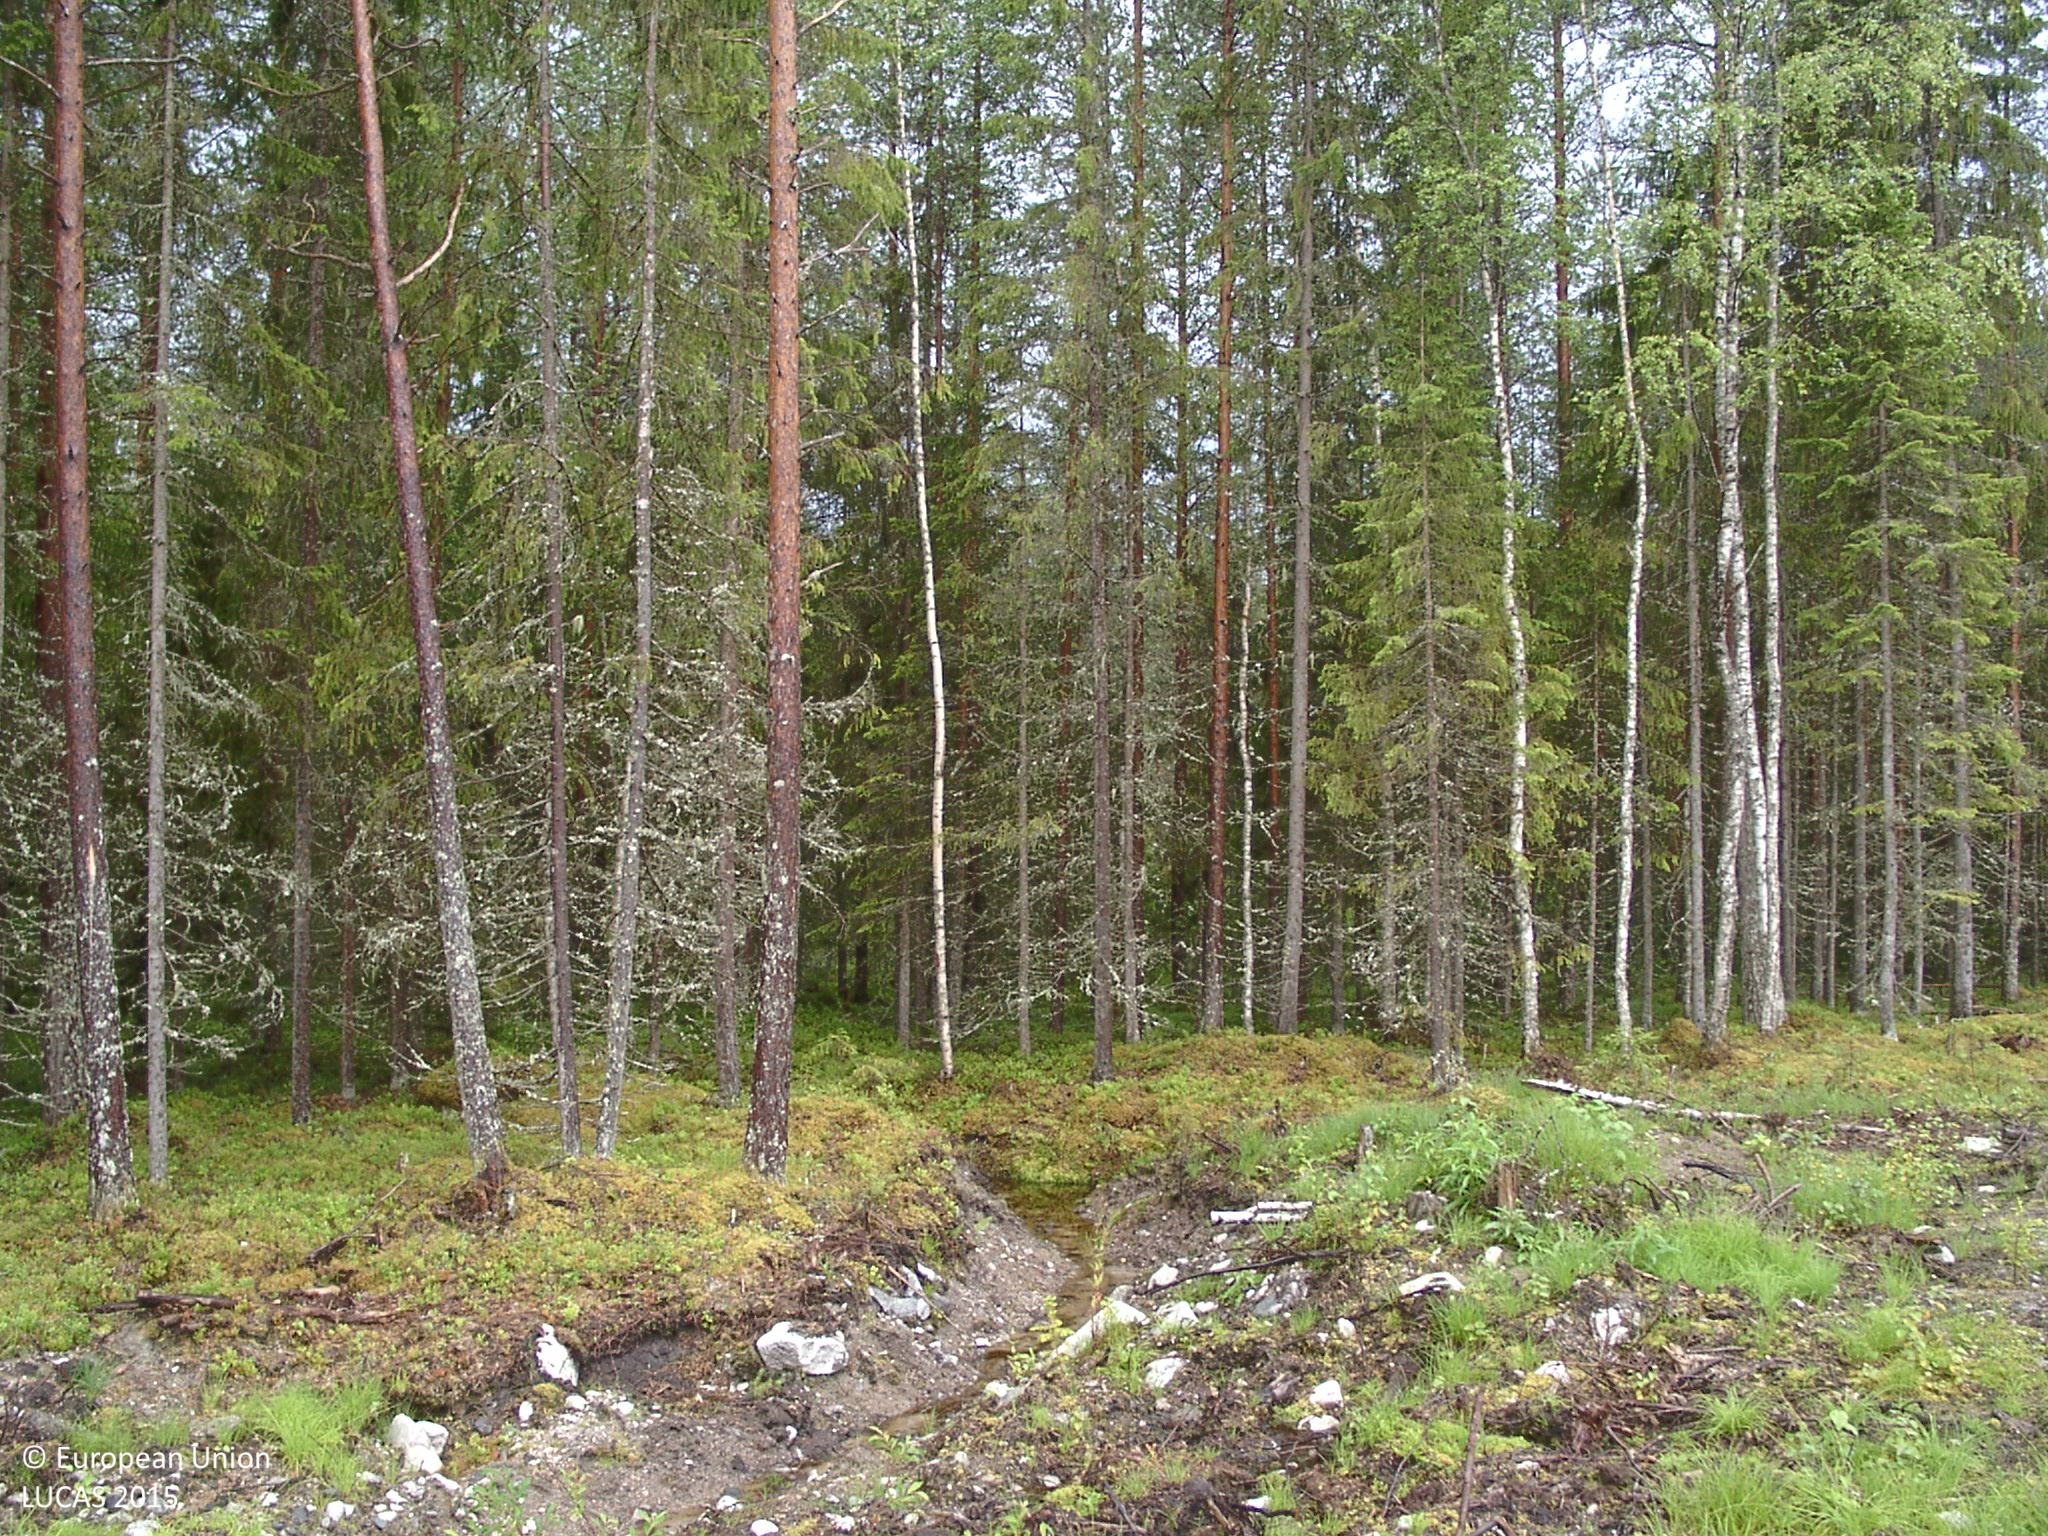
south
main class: Grassland
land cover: Grassland with sparse tree/shrub cover
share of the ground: 25 - 50 %
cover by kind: herbaceous plants 25 %, unconsolidated bare surface 25 %, lichens and mosses 10 %, broadleaved forest trees 5 %
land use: Forestry
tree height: < 5 m
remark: Nursery
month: August
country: FI
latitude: 62.8128
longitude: 24.6264
